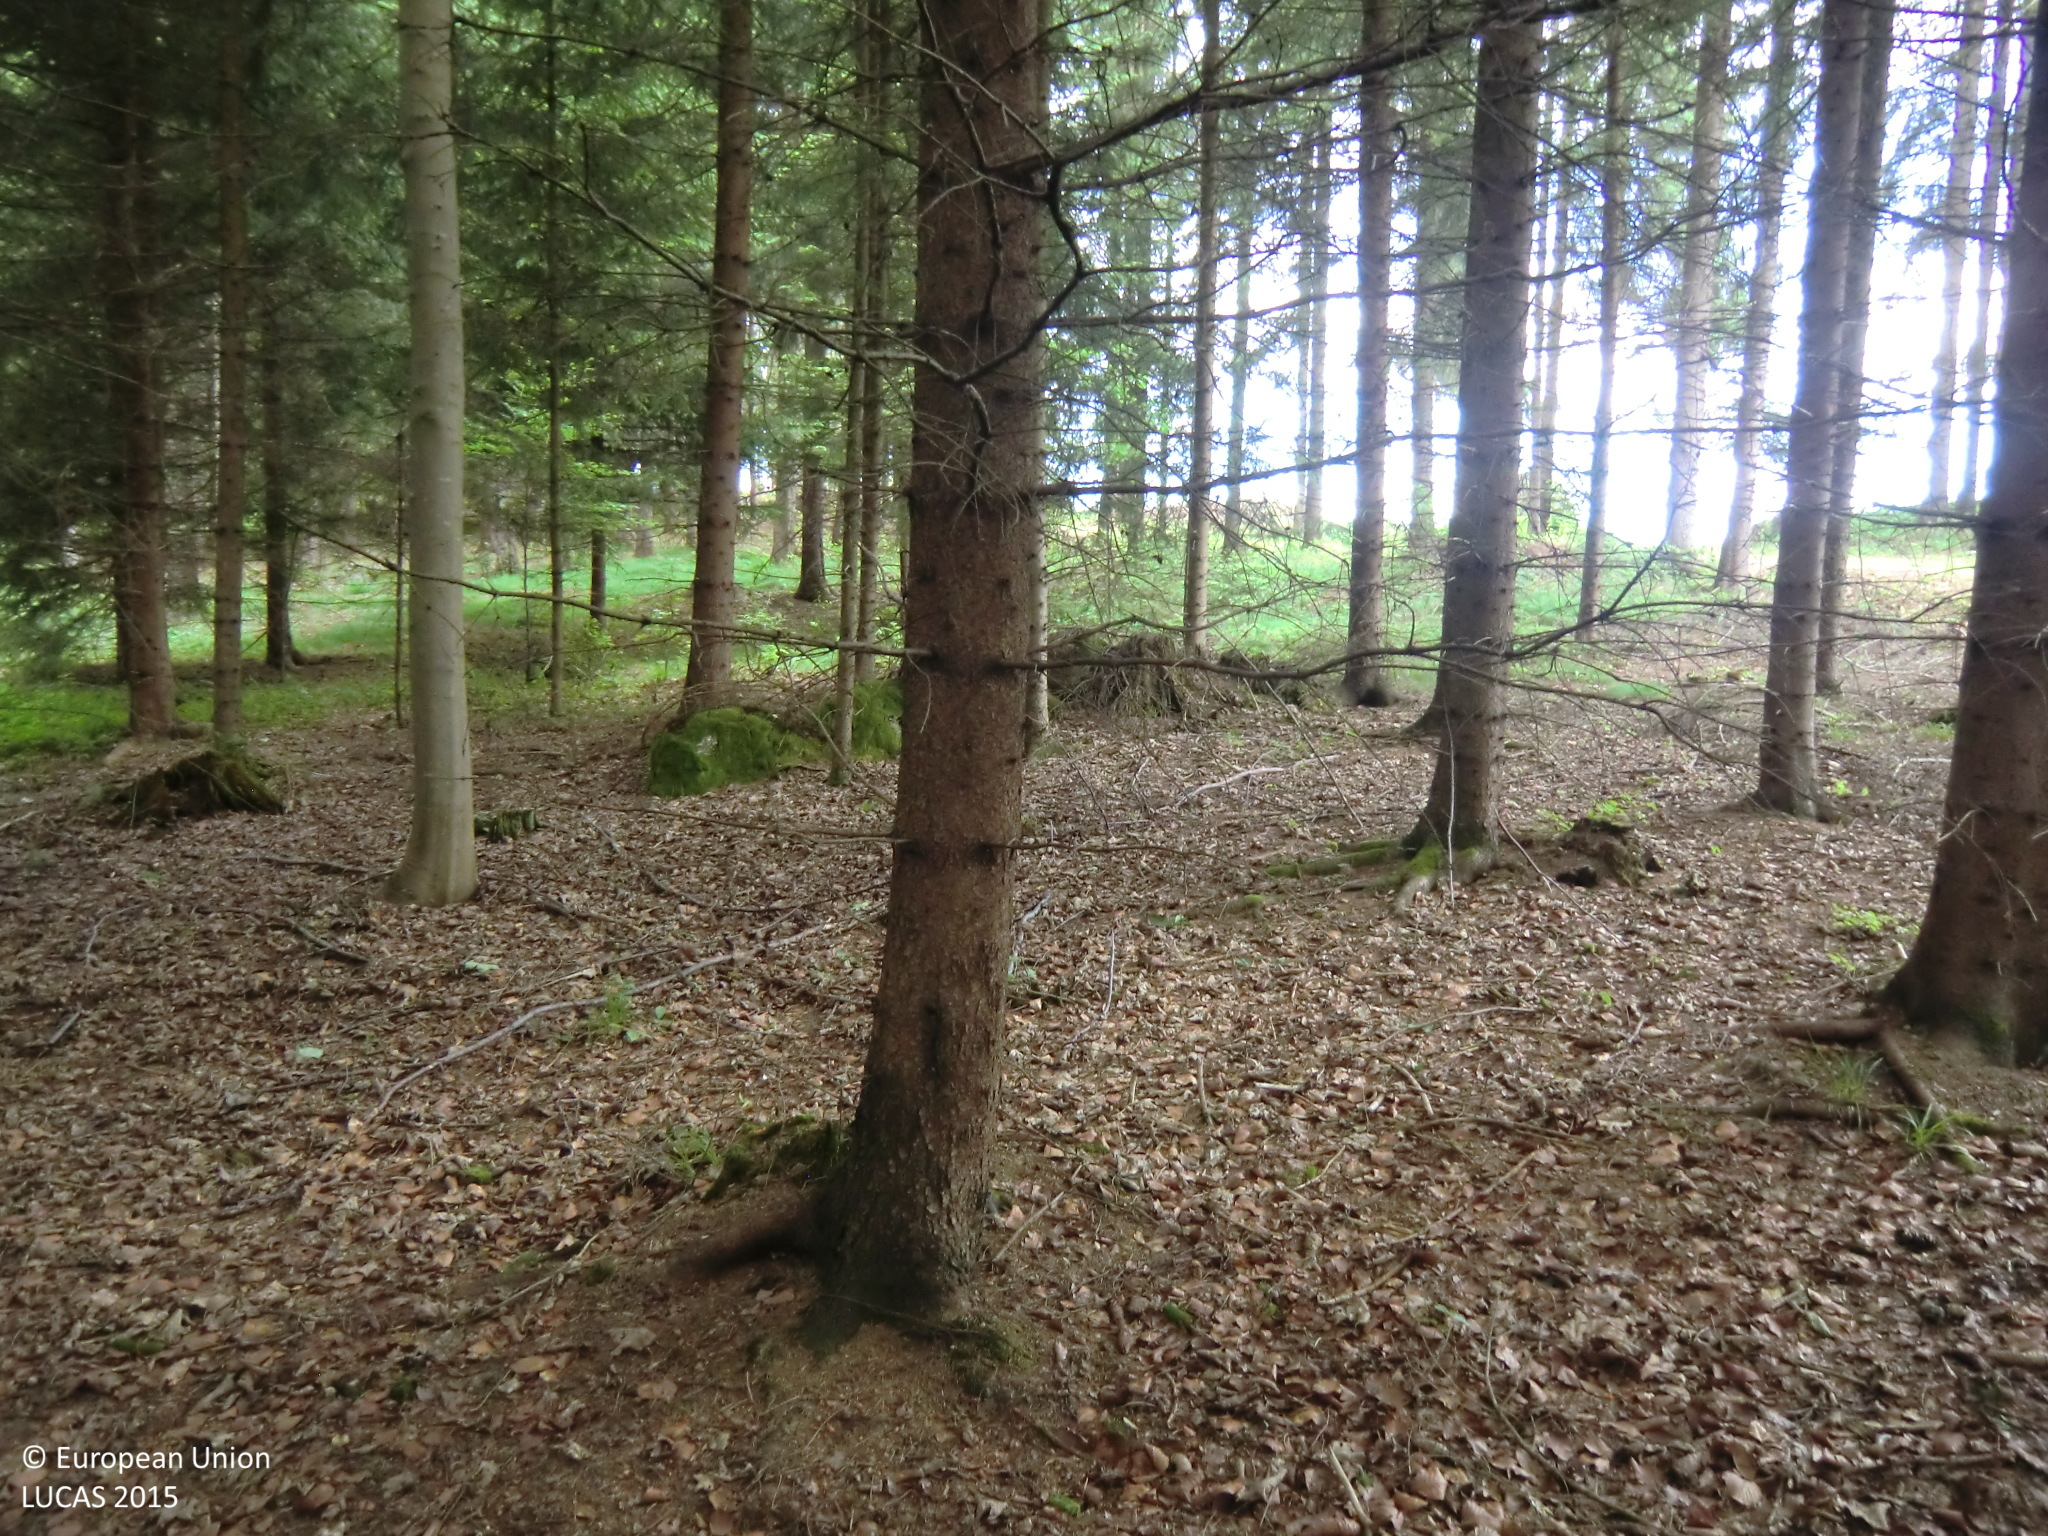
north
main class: Woodland
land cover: Spruce dominated mixed woodland
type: hemiboreal forest and nemoral coniferous forest and mixed broadleaved-coniferous forest
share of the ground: > 75 %
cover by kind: coniferous forest trees 70 %, broadleaved forest trees 25 %, unconsolidated bare surface 5 %
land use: Forestry
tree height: > 5 m
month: June
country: AT
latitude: 48.4722
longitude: 14.9657
